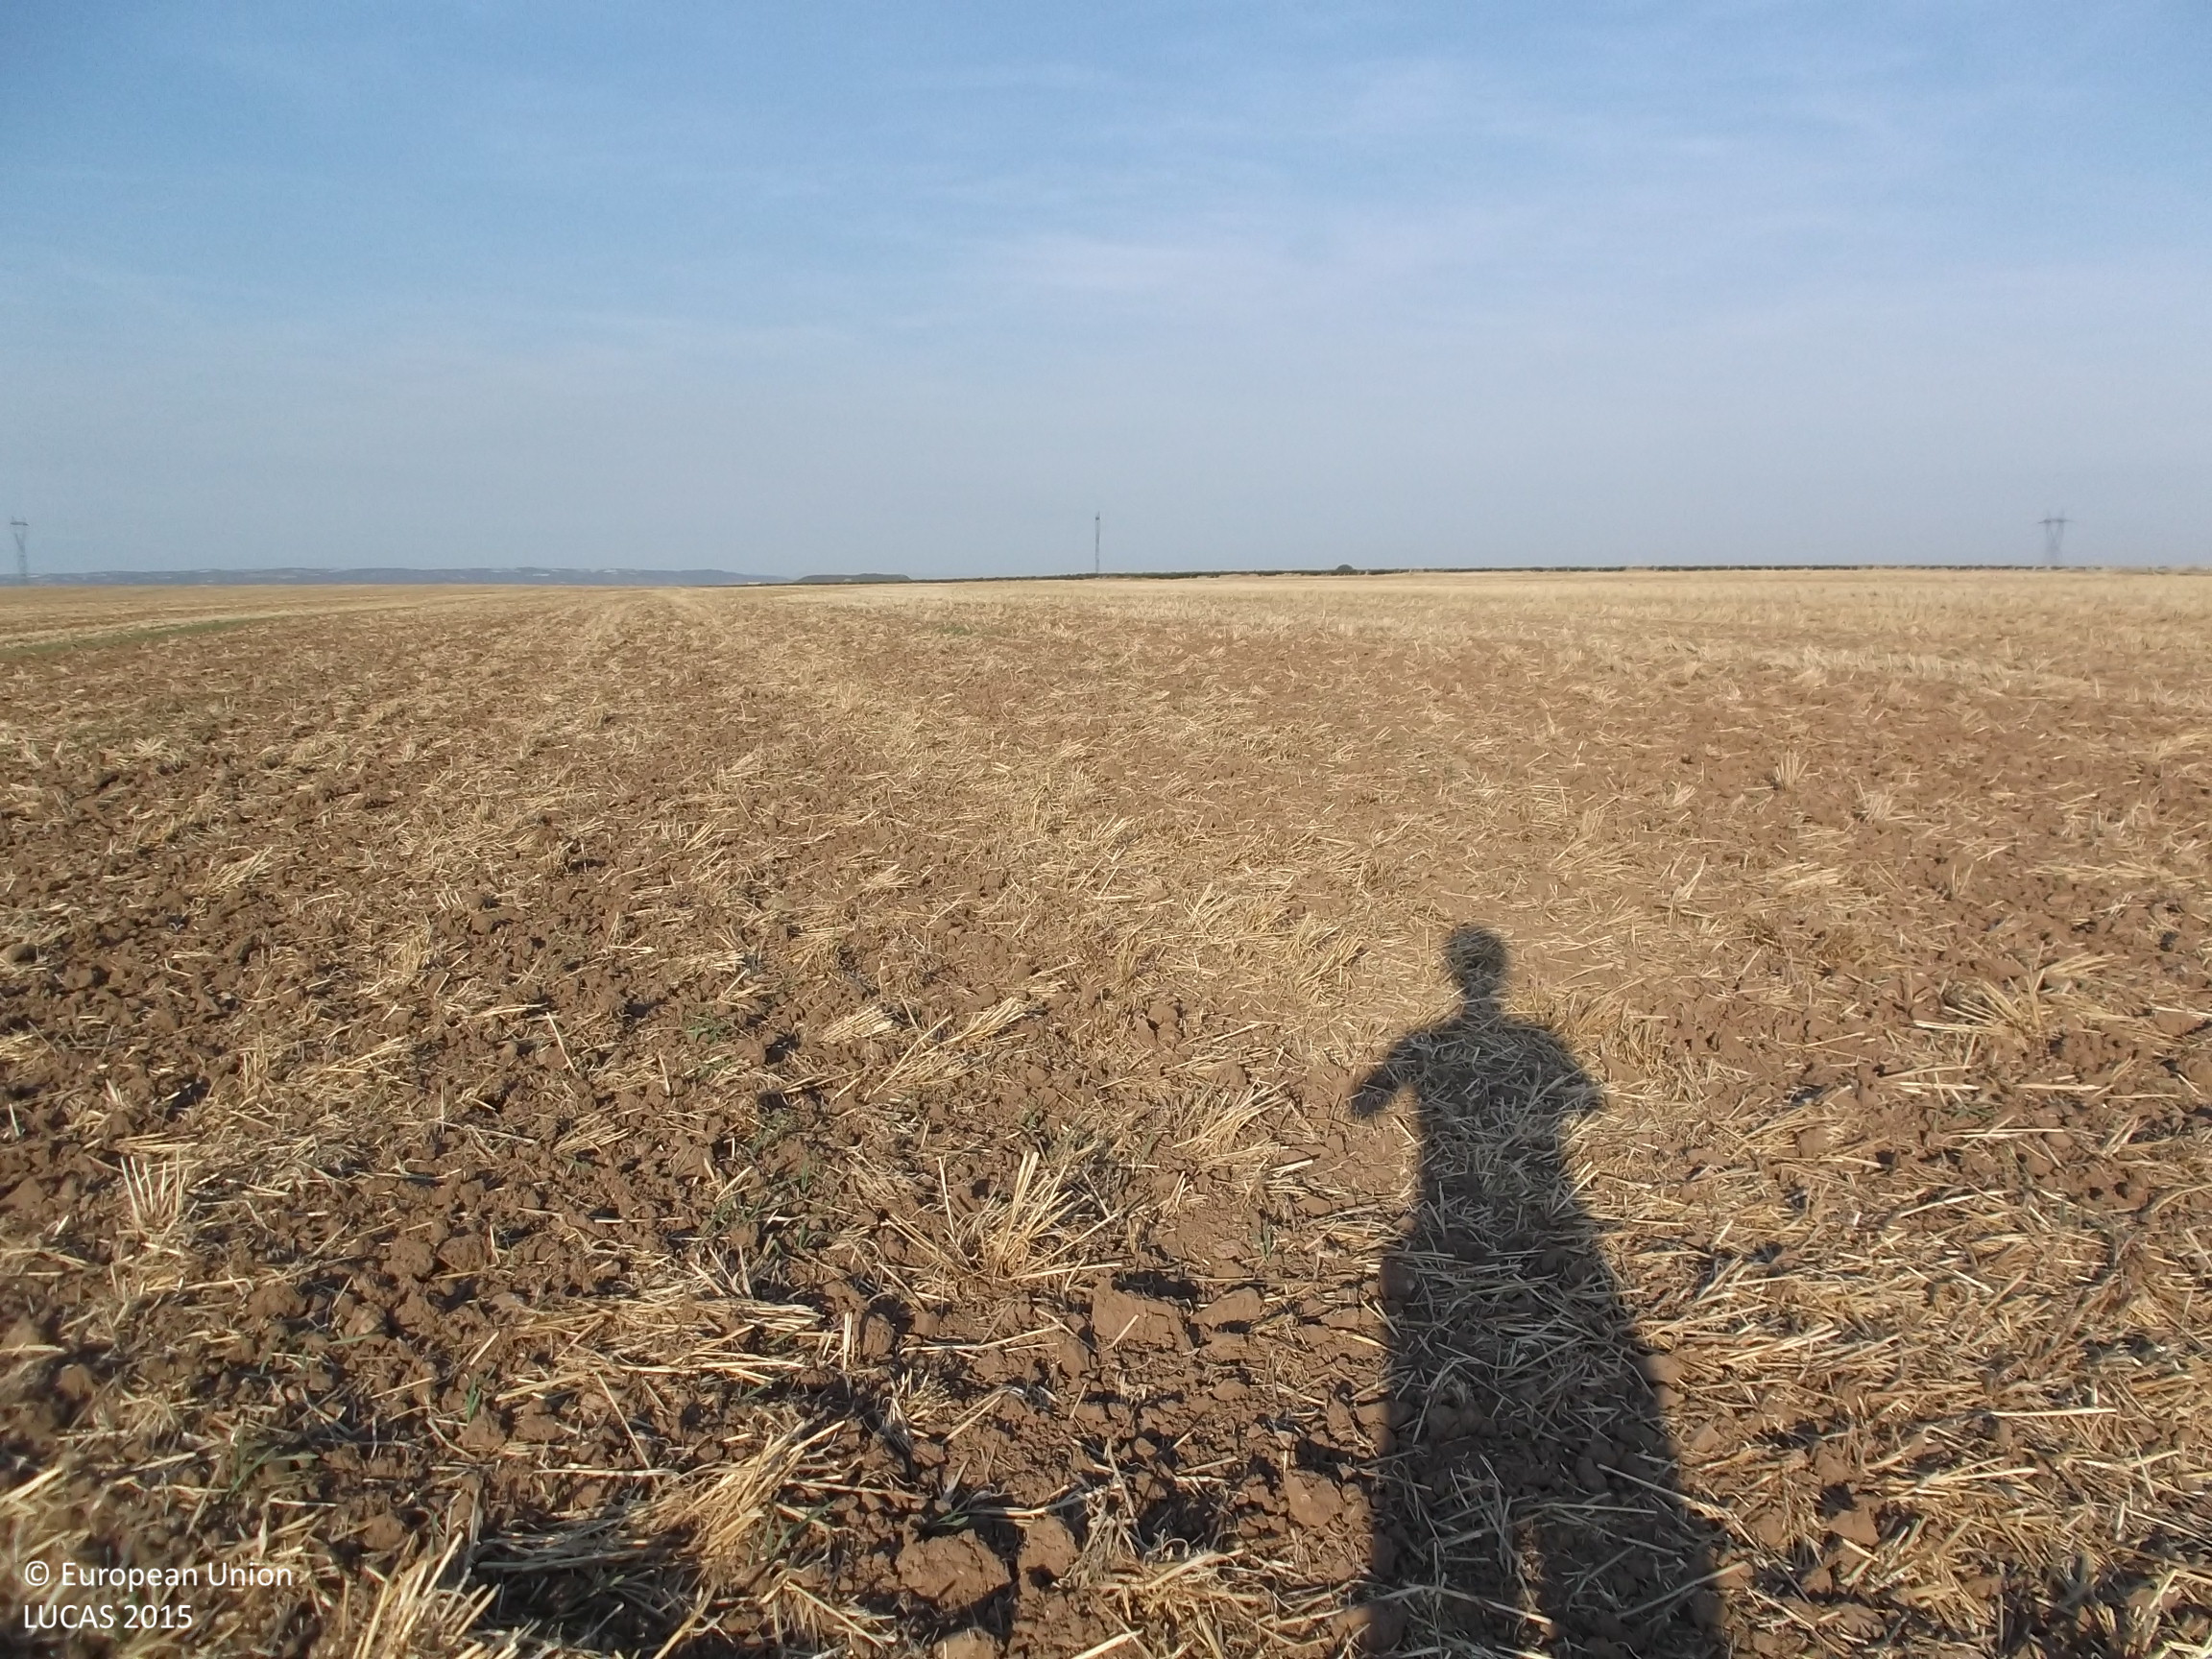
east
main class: Cropland
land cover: Barley
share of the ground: < 10 %
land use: Agriculture (excluding fallow land and kitchen gardens)
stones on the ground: < 10 %
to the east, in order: Barley
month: July
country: ES
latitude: 42.3944
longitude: -1.6858
